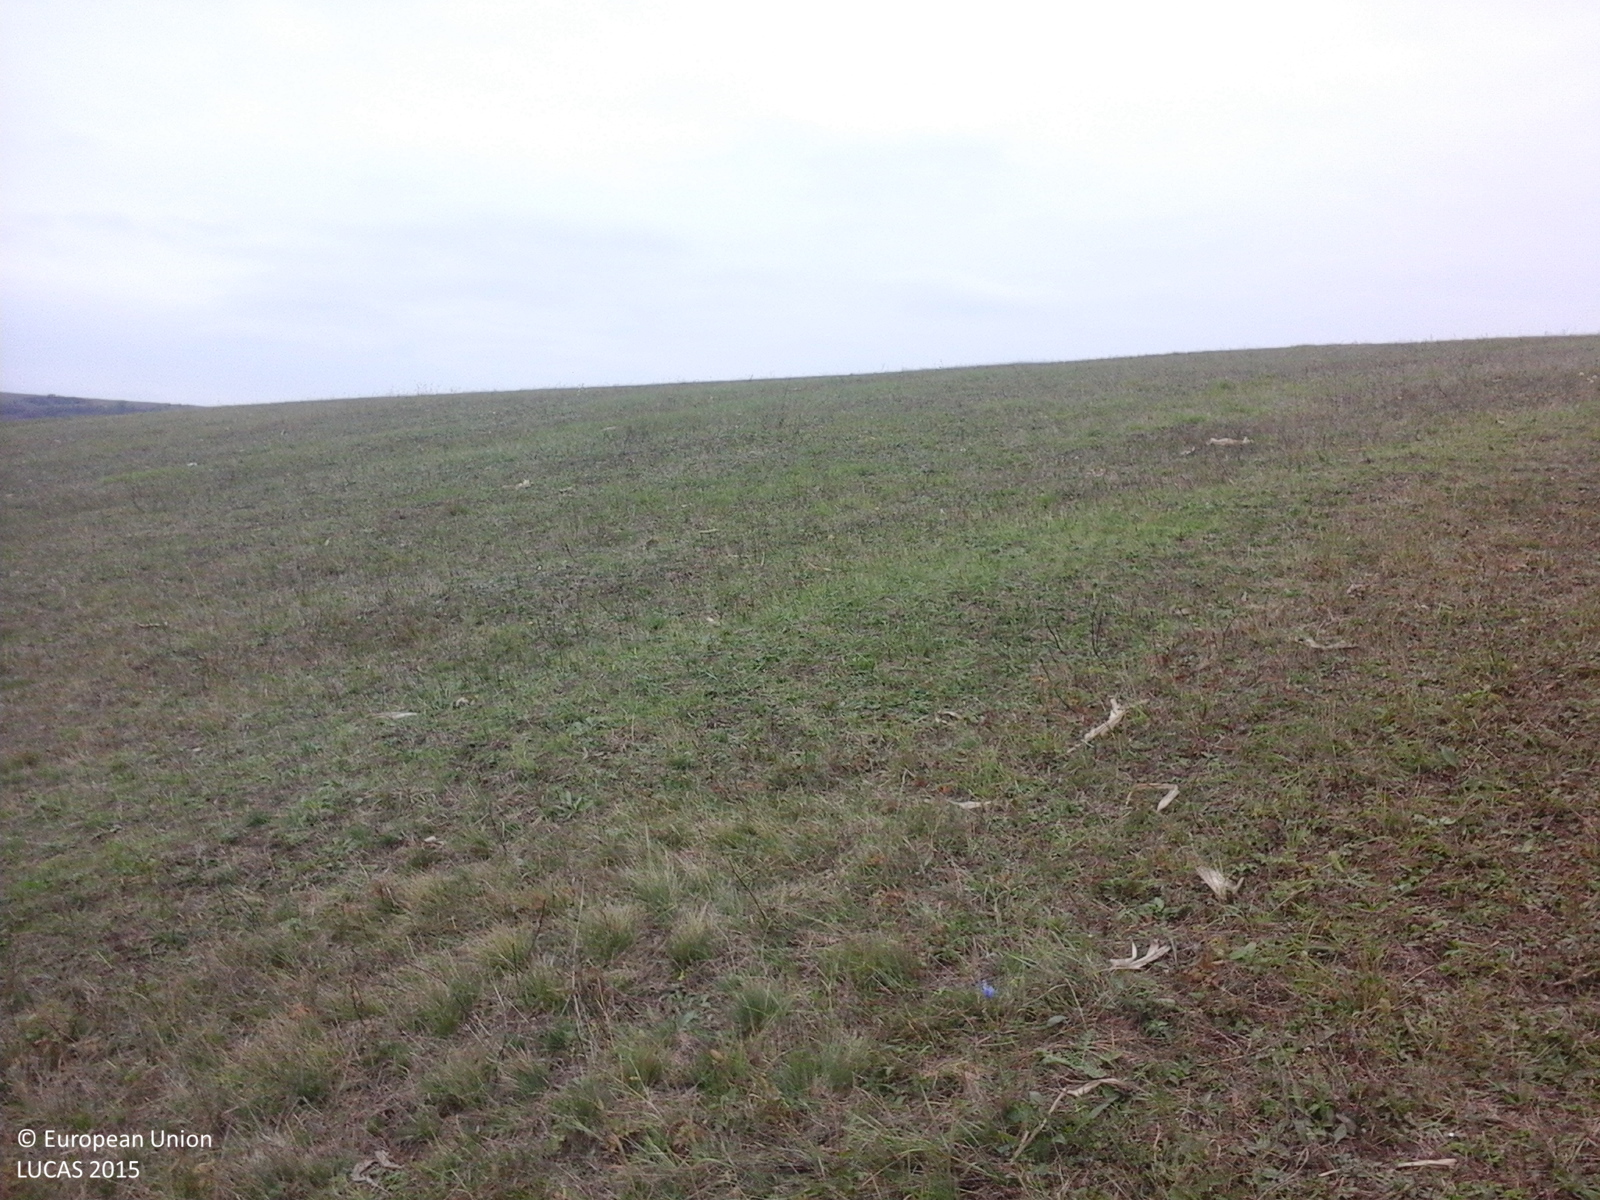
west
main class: Grassland
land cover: Grassland without tree/shrub cover
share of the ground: > 75 %
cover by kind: herbaceous plants 100 %
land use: Agriculture (excluding fallow land and kitchen gardens)
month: October
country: RO
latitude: 46.1104
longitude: 25.2507
